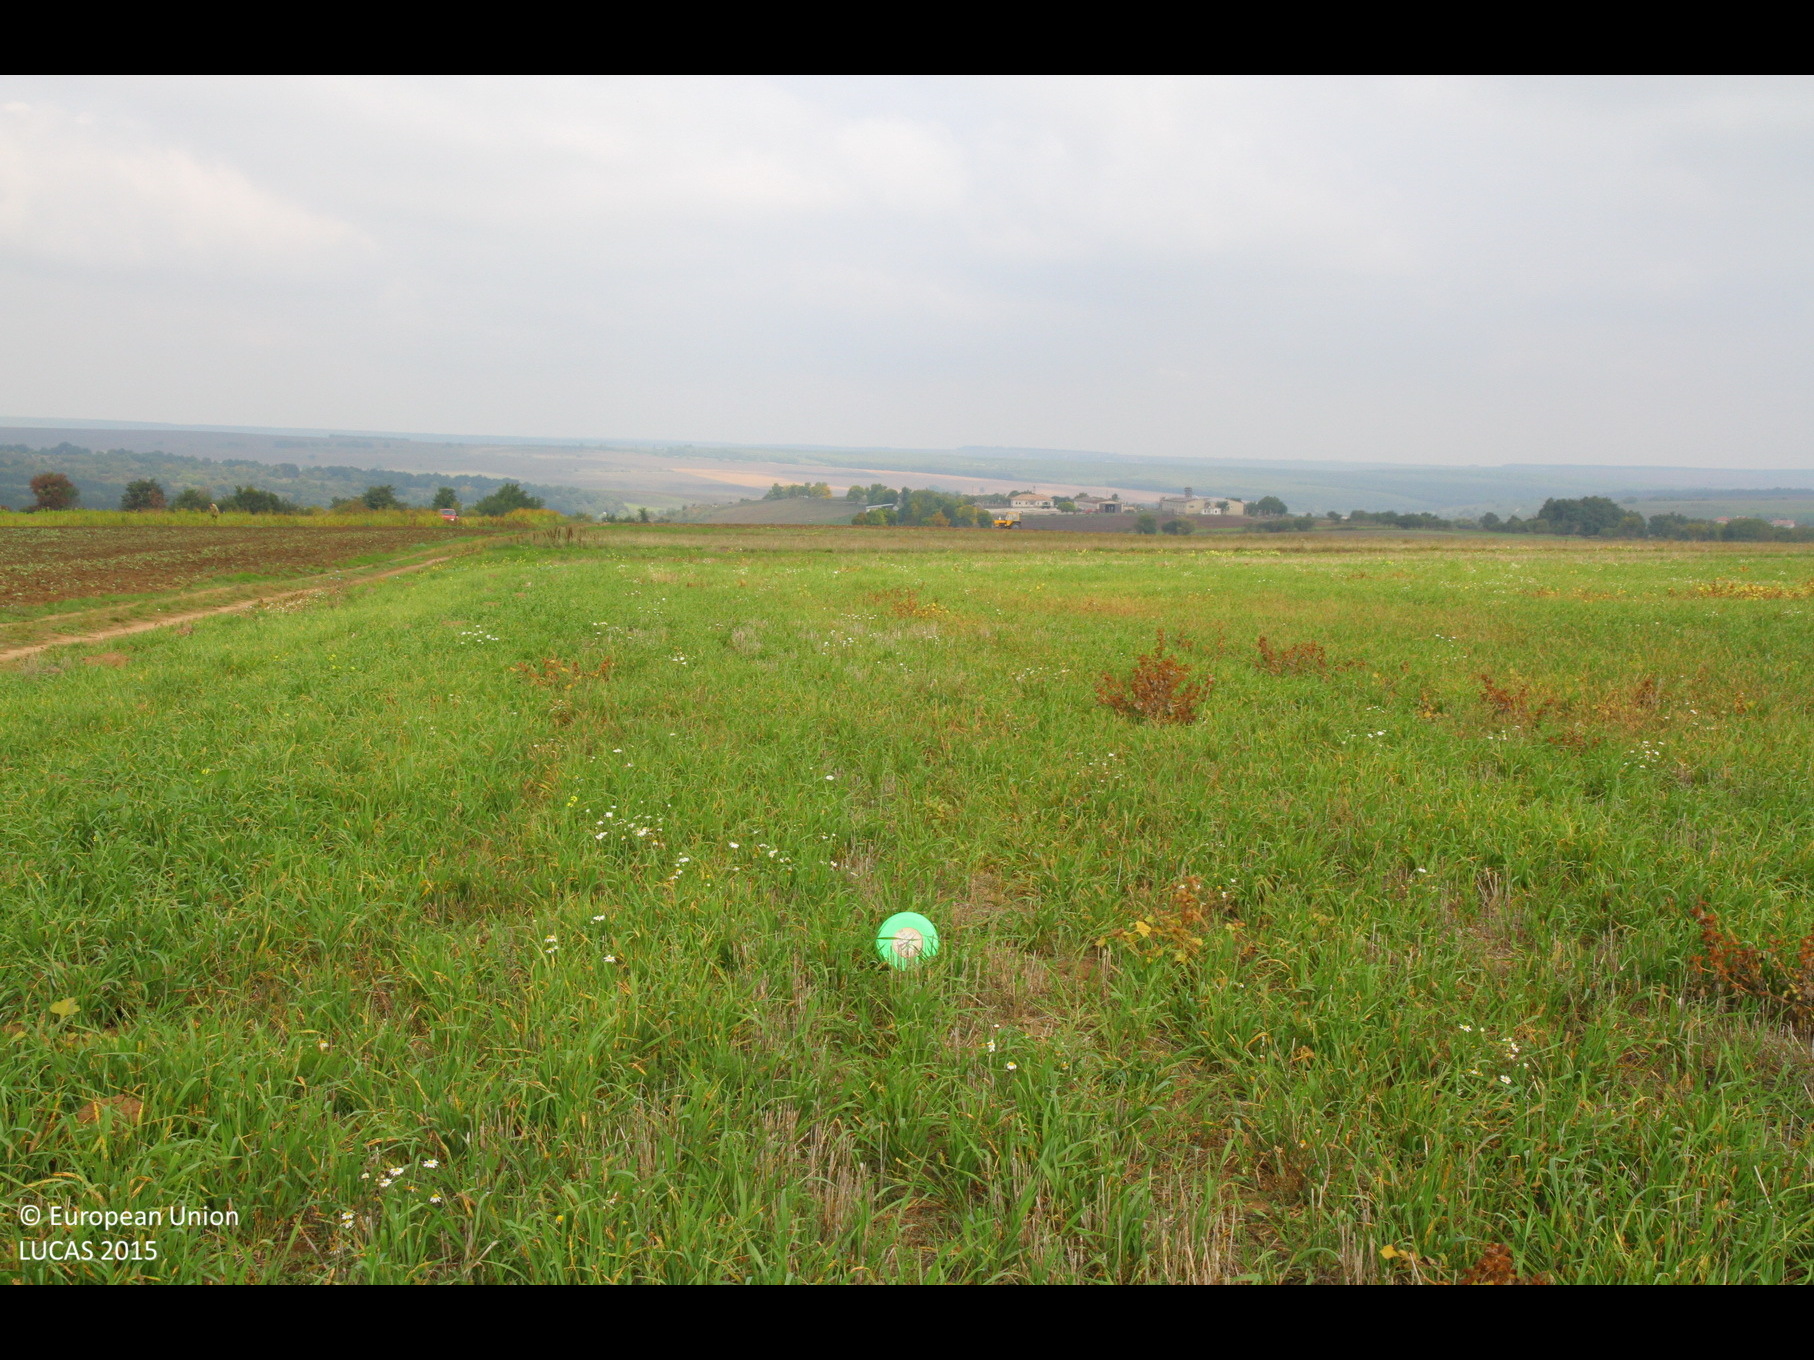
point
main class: Cropland
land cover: Common wheat
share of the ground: < 10 %
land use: Agriculture (excluding fallow land and kitchen gardens)
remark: Harvested field
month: October
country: BG
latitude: 43.5231
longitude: 27.0059
